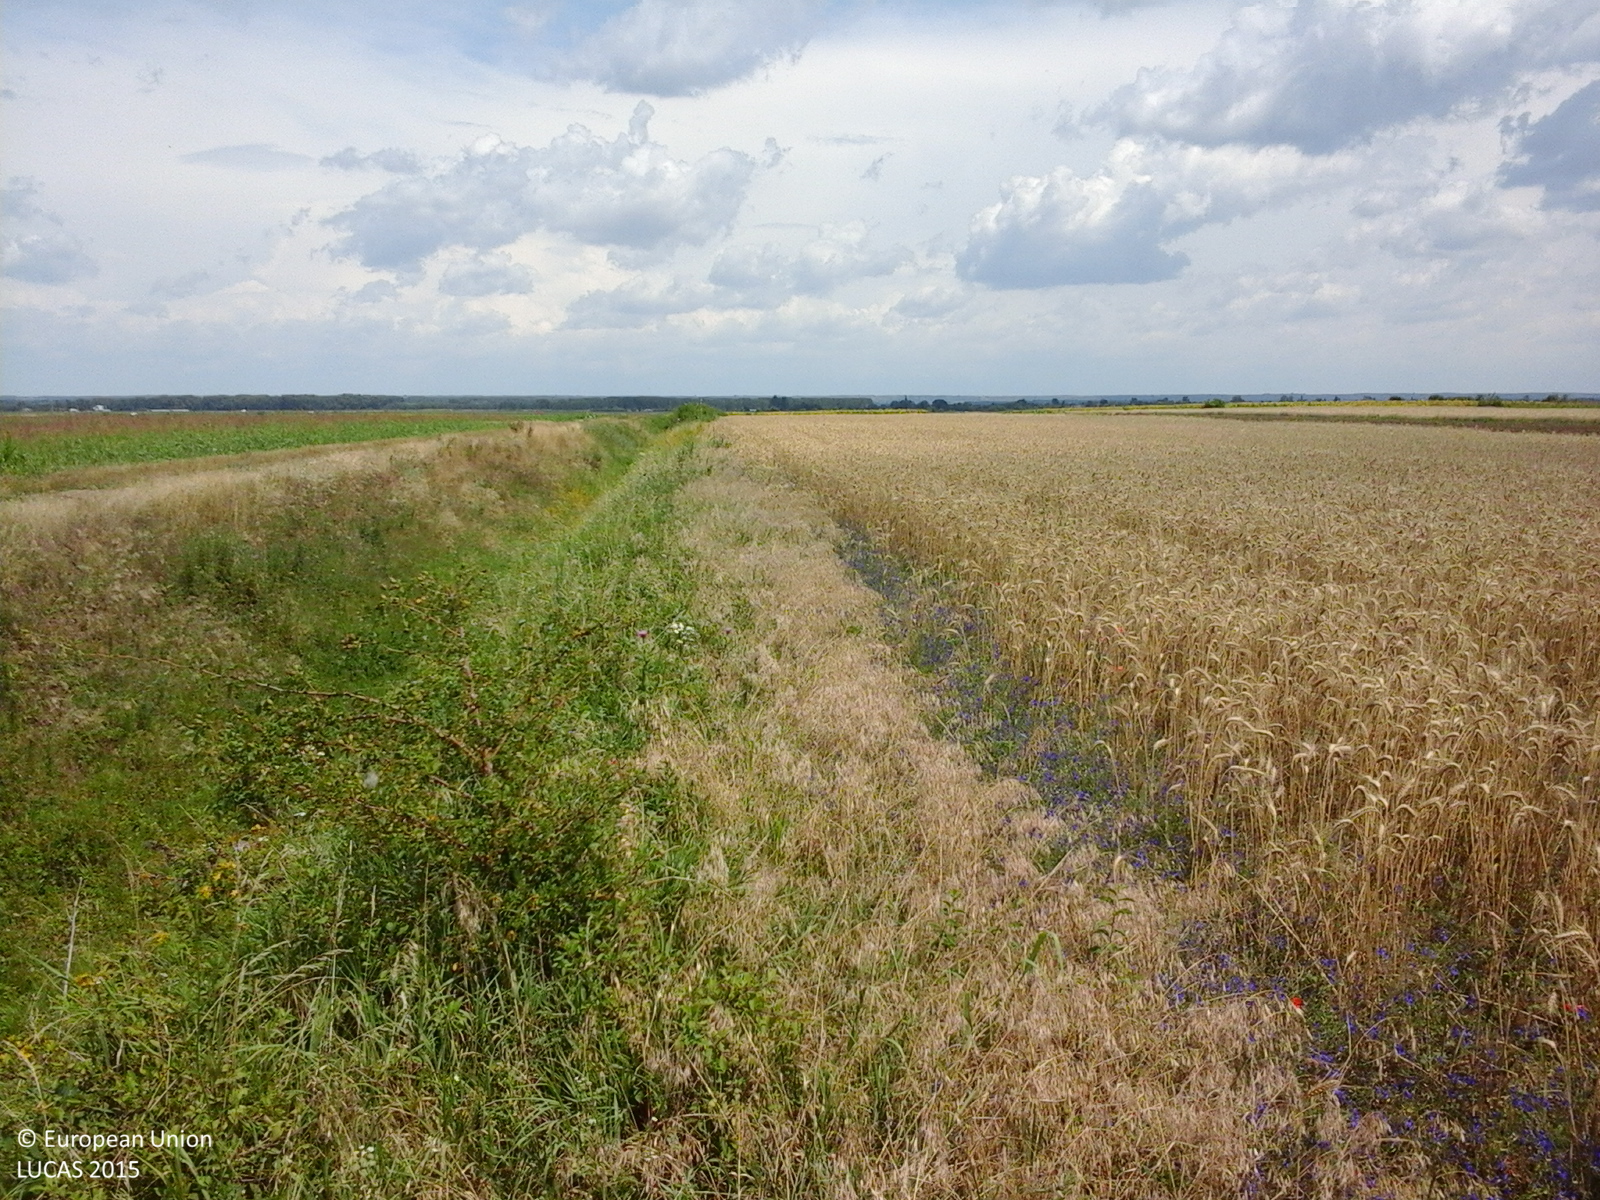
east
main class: Cropland
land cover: Common wheat
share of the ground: > 75 %
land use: Agriculture (excluding fallow land and kitchen gardens)
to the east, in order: Common wheat; Maize
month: July
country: RO
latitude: 43.9577
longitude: 24.5606
